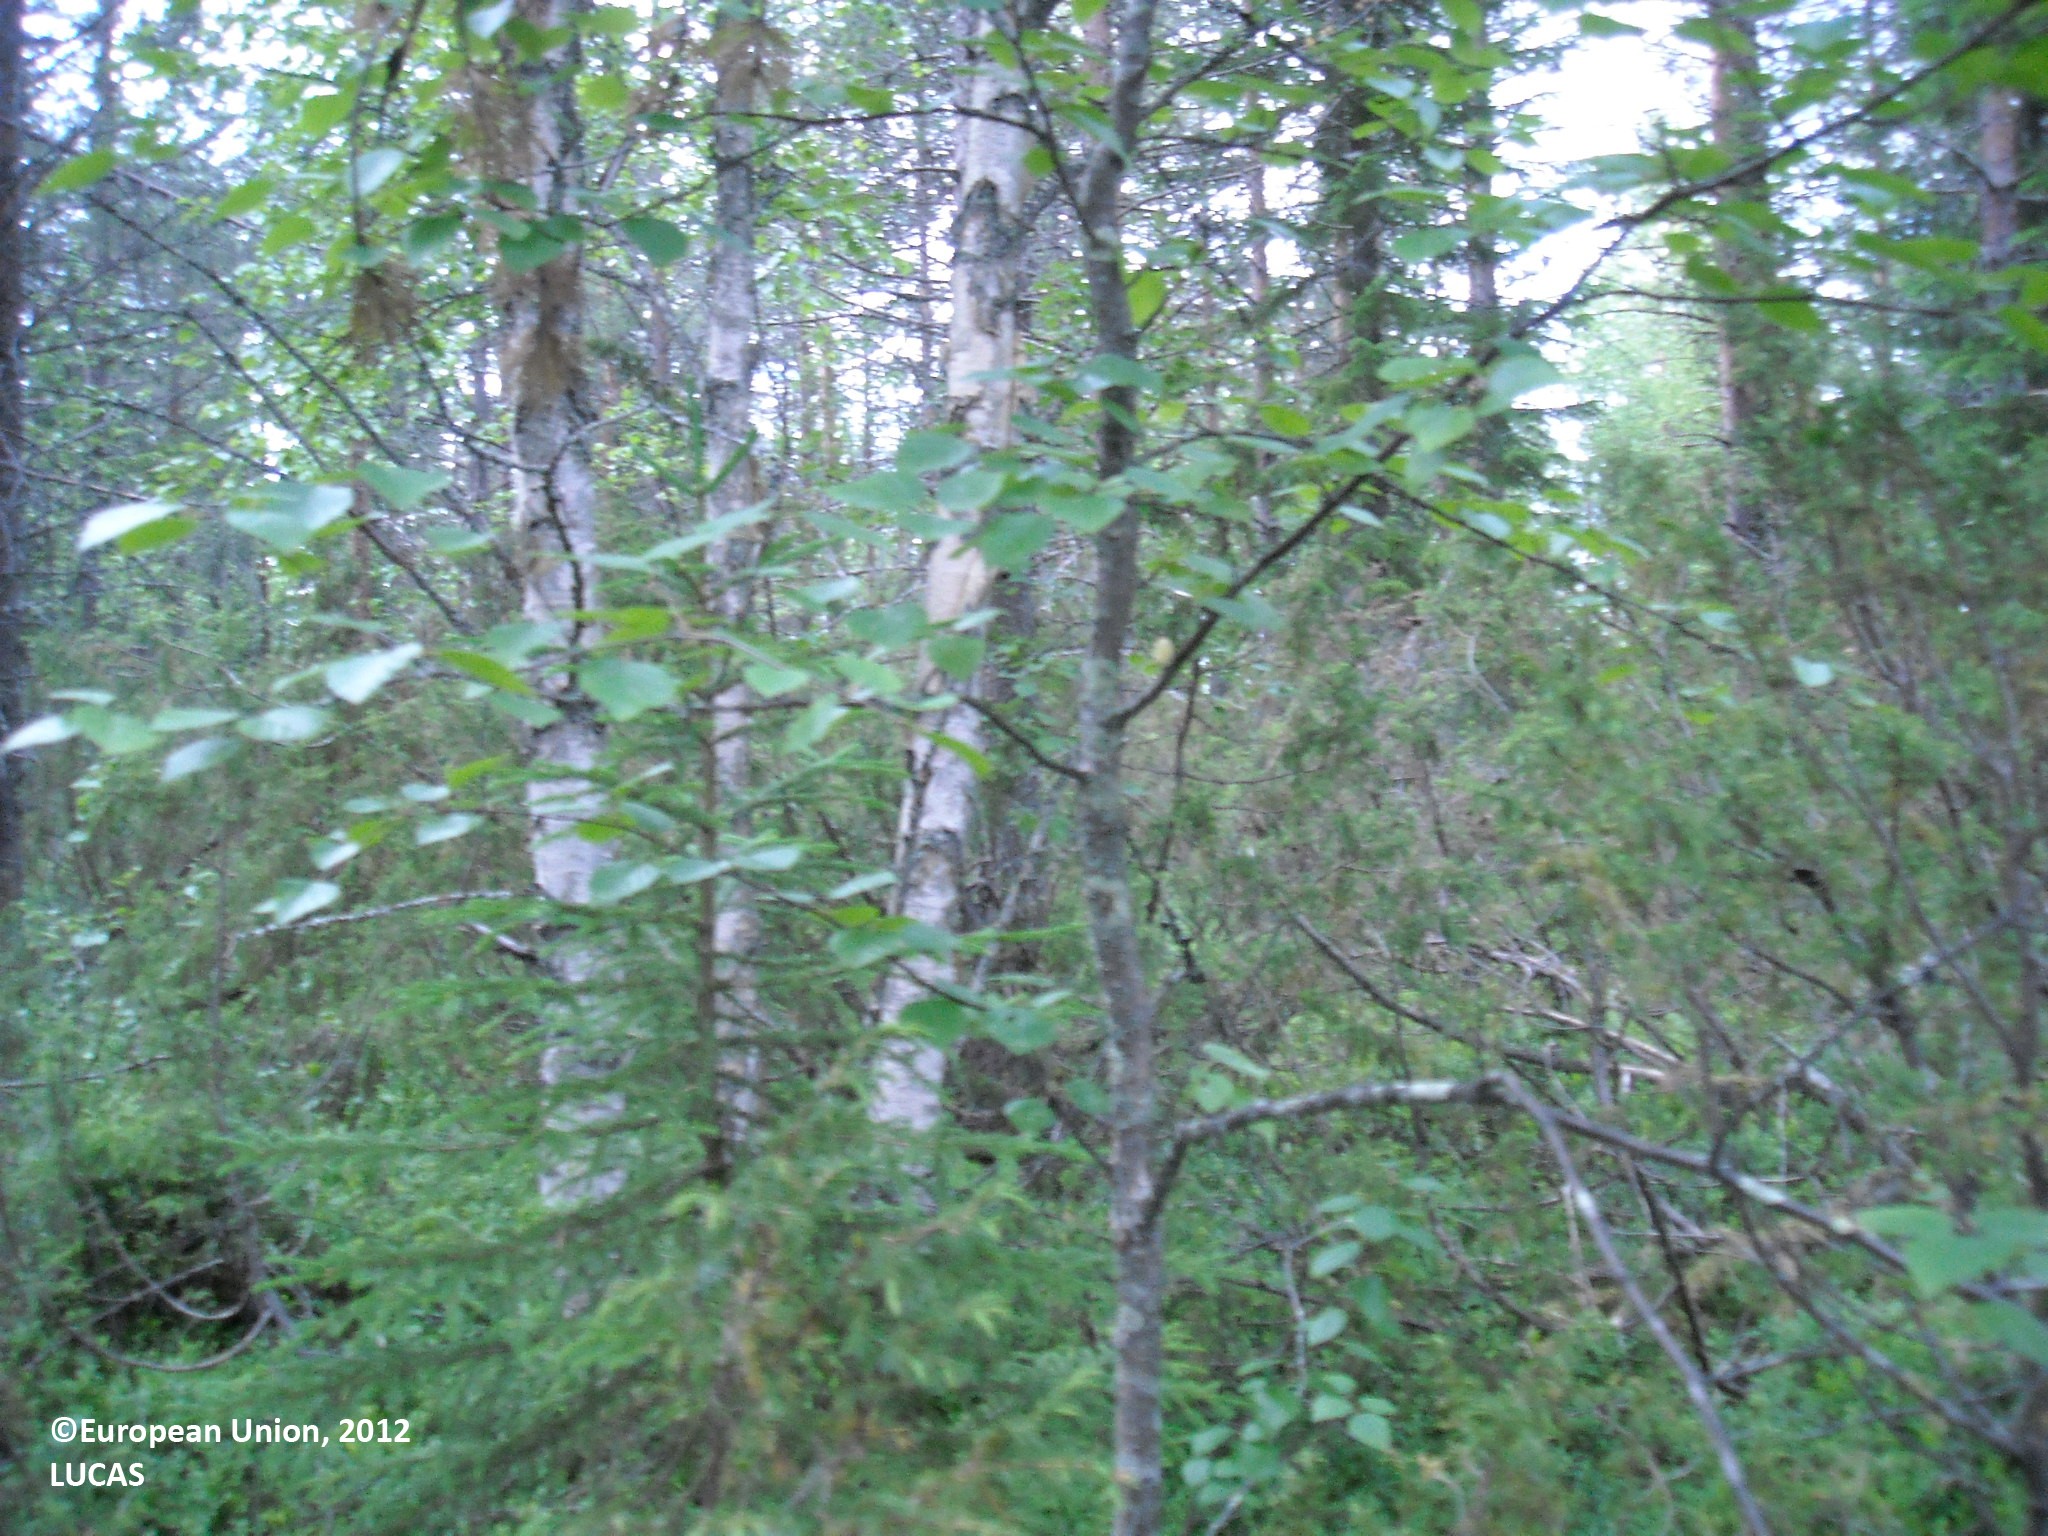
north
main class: Woodland
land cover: Other coniferous woodland
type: boreal forest
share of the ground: > 75 %
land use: Forestry
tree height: > 5 m
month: July
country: FI
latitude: 64.6112
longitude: 27.7718
